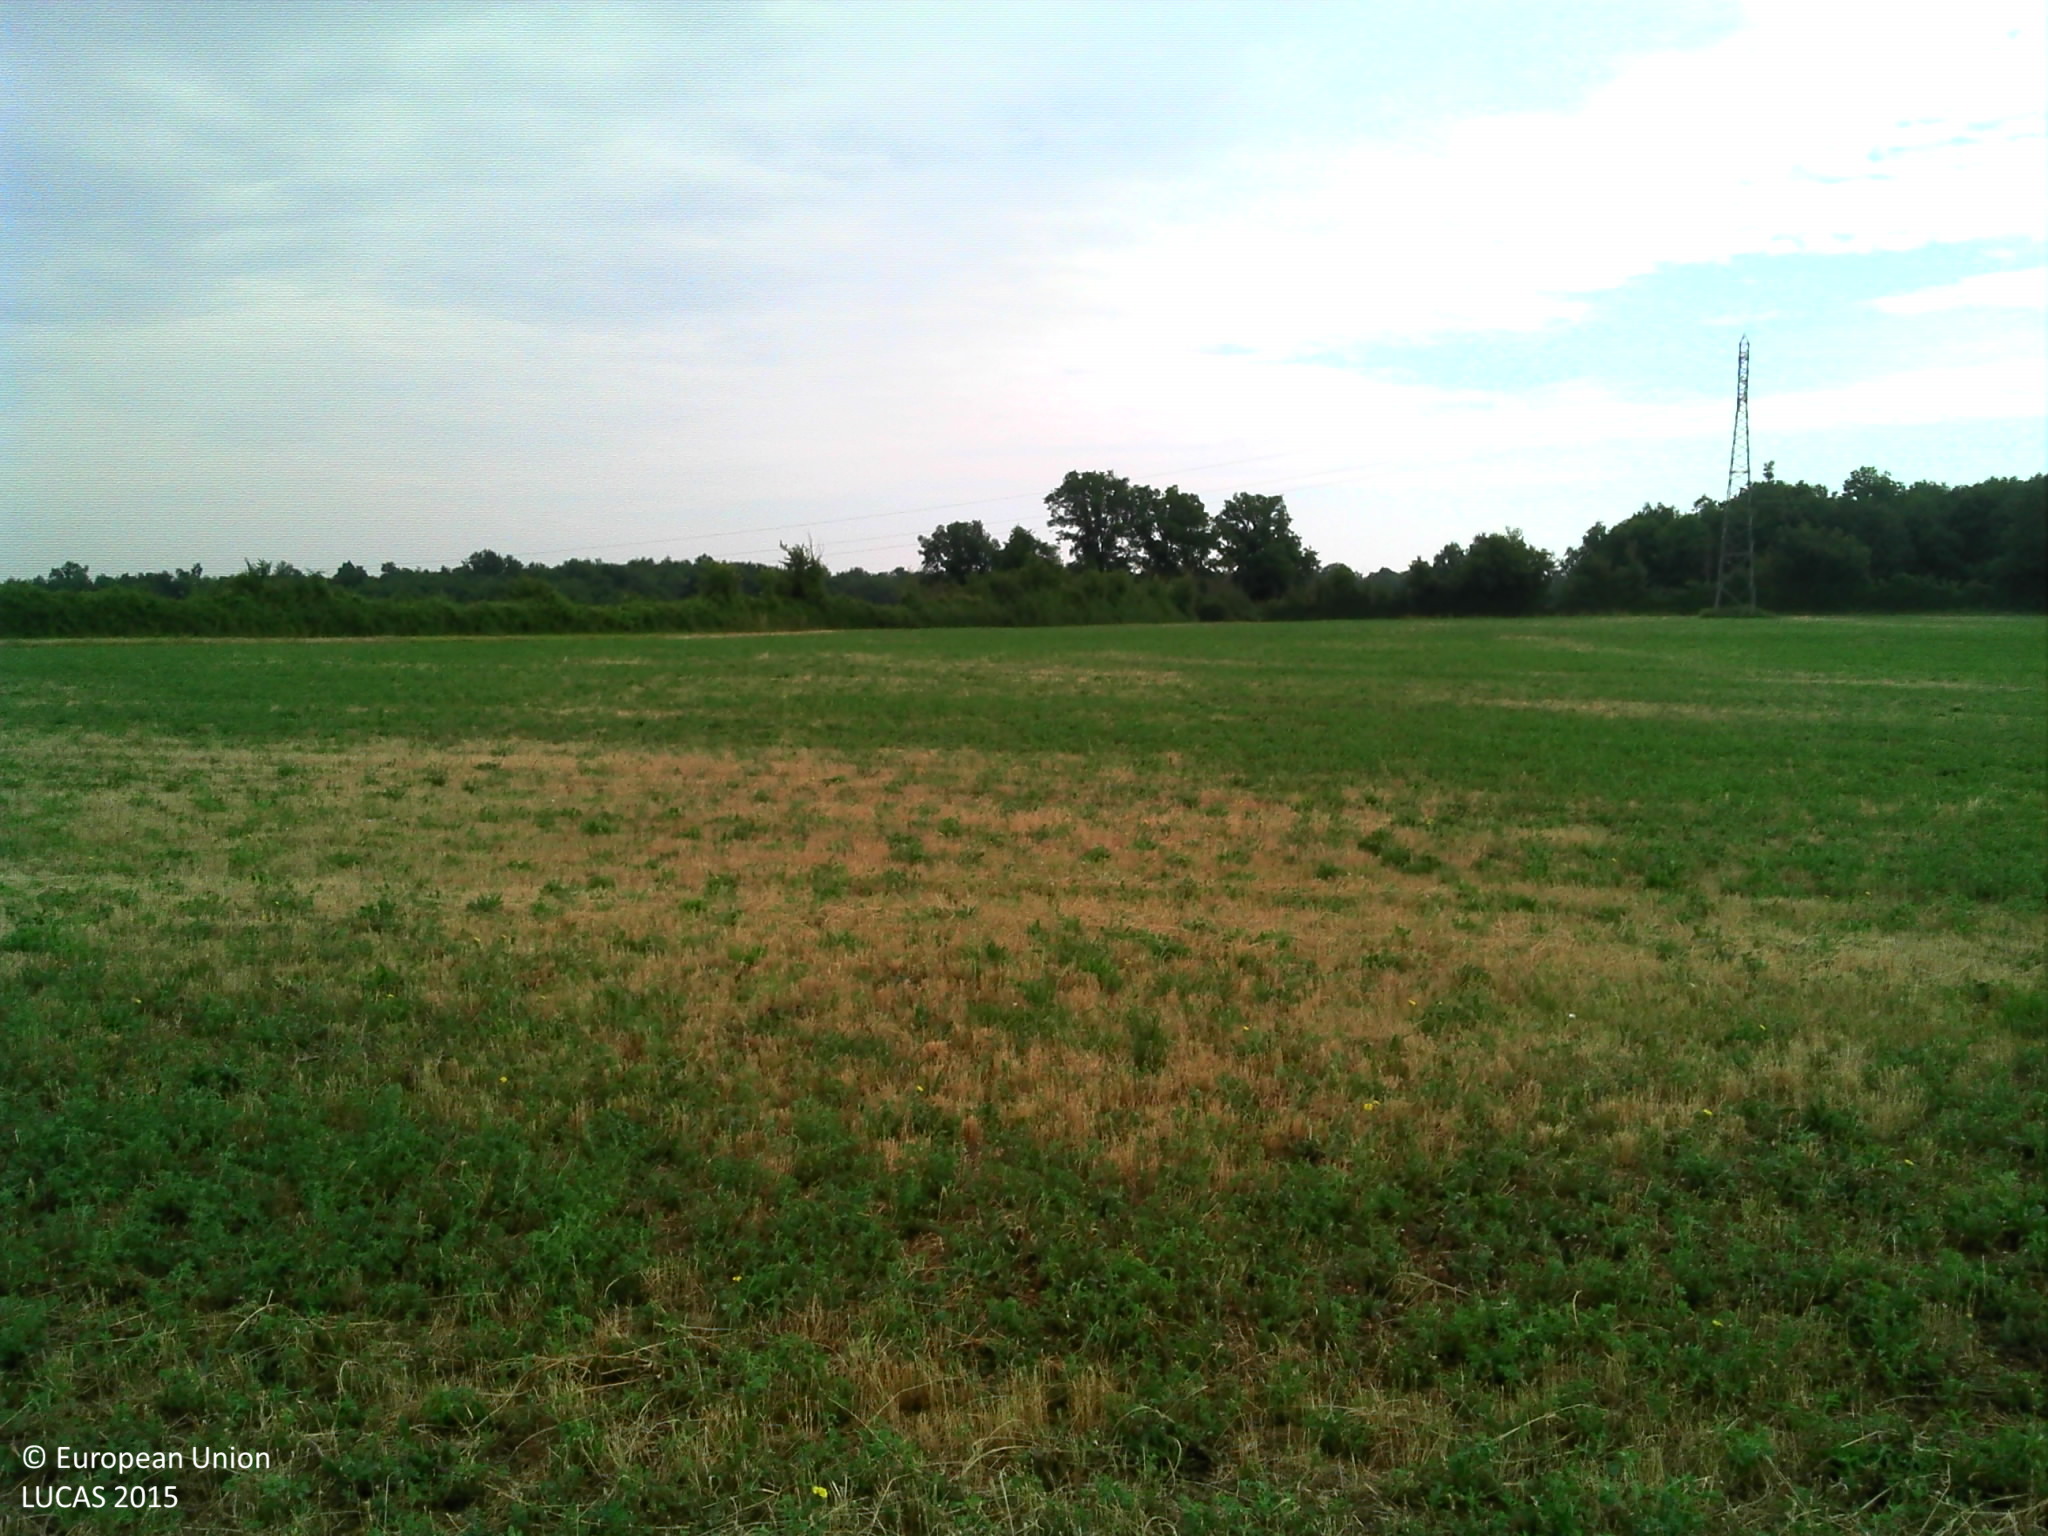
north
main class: Cropland
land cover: Lucerne
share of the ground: > 75 %
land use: Agriculture (excluding fallow land and kitchen gardens)
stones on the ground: < 10 %
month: June
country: FR
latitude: 45.9809
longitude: 0.2892
